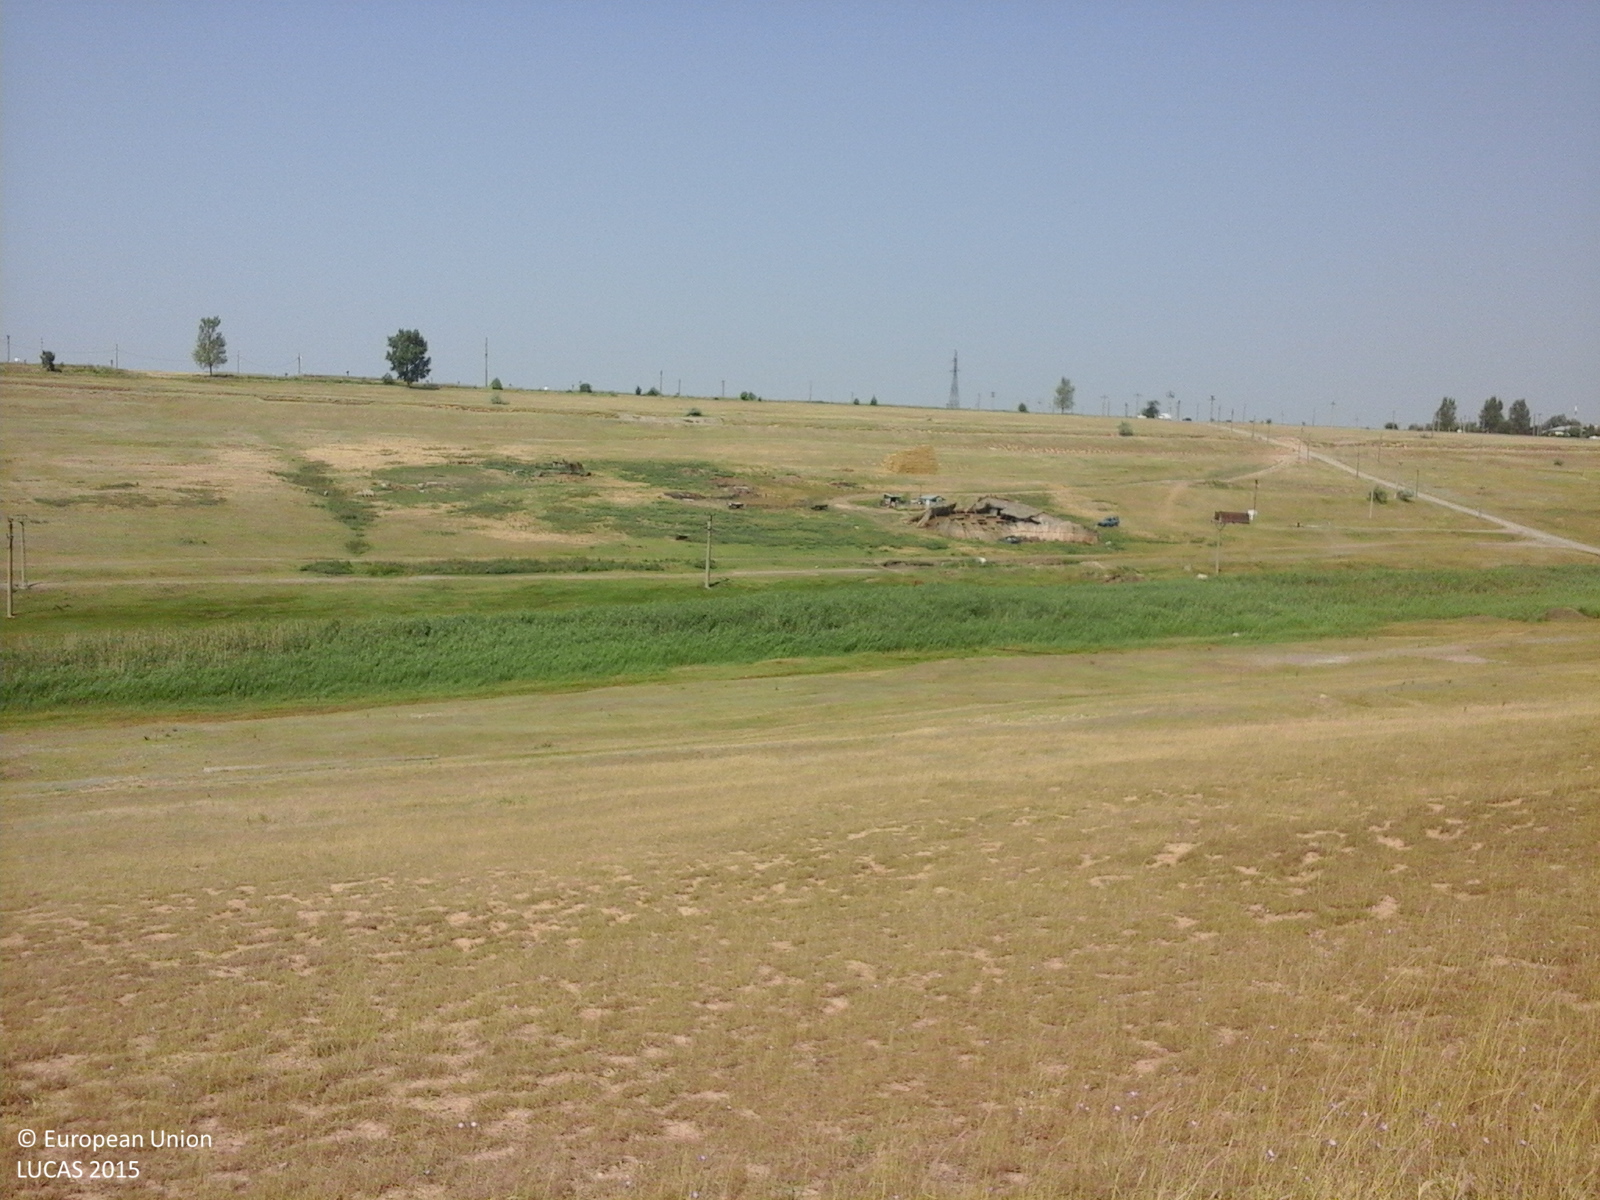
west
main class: Grassland
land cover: Grassland without tree/shrub cover
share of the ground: > 75 %
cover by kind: herbaceous plants 100 %
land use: Agriculture (excluding fallow land and kitchen gardens)
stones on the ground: 10 - 25 %
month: July
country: RO
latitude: 45.5388
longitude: 27.8238
